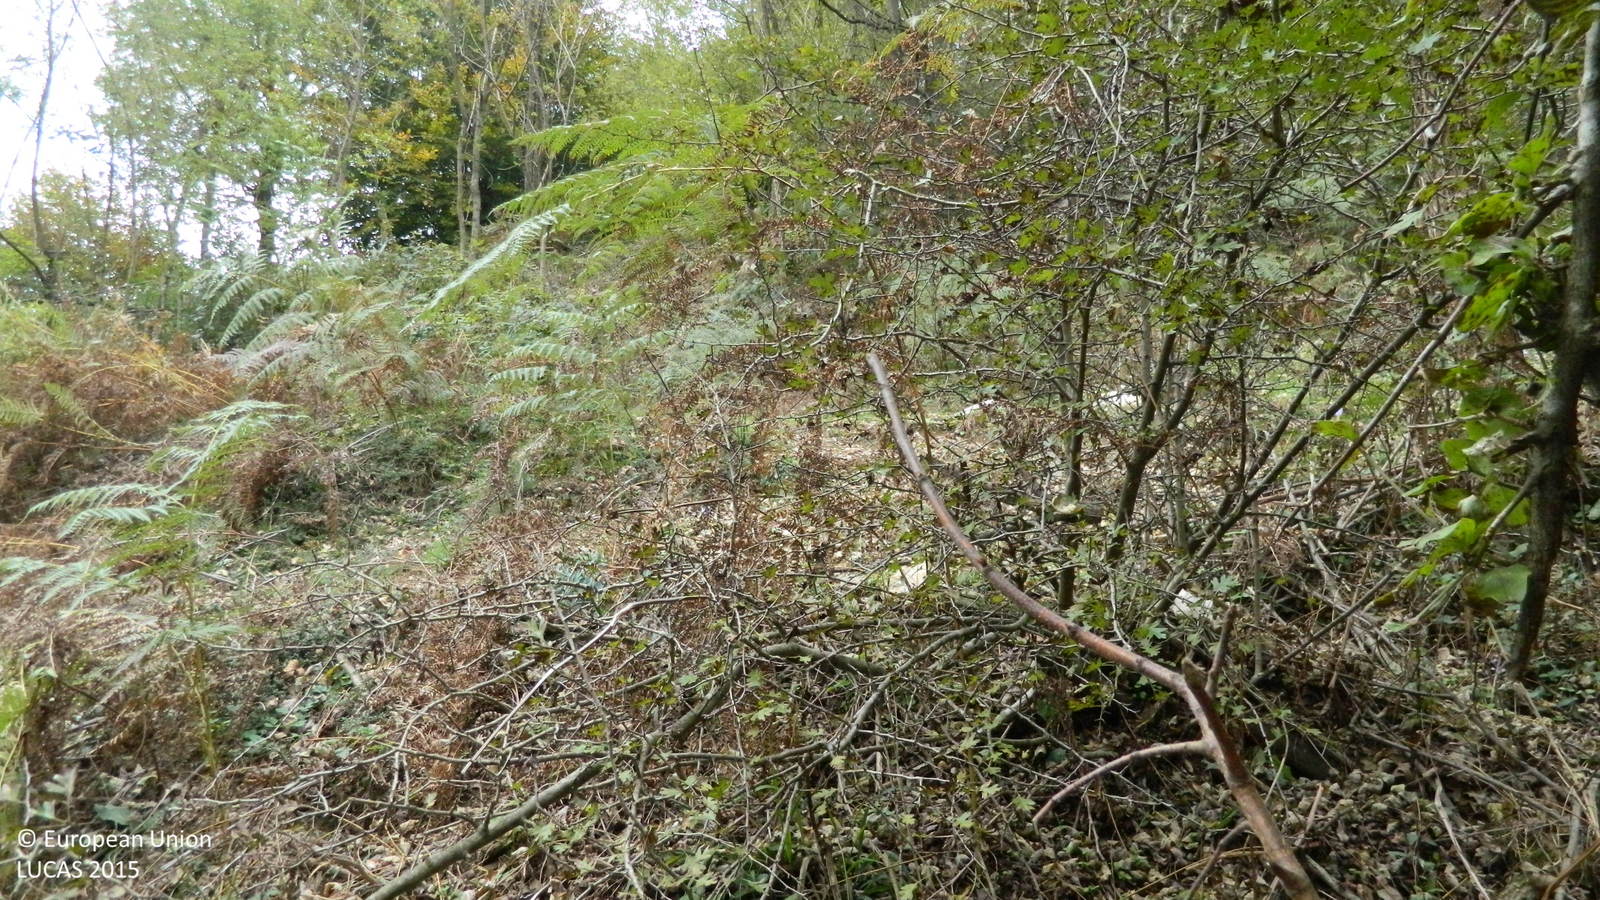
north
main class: Woodland
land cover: Broadleaved woodland
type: mesophytic deciduous forest
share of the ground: > 75 %
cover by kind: broadleaved forest trees 75 %, shrubs 15 %, herbaceous plants 5 %, unconsolidated bare surface 5 %
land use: Forestry
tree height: > 5 m
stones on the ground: < 10 %
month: October
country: BG
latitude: 41.3107
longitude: 25.2317
